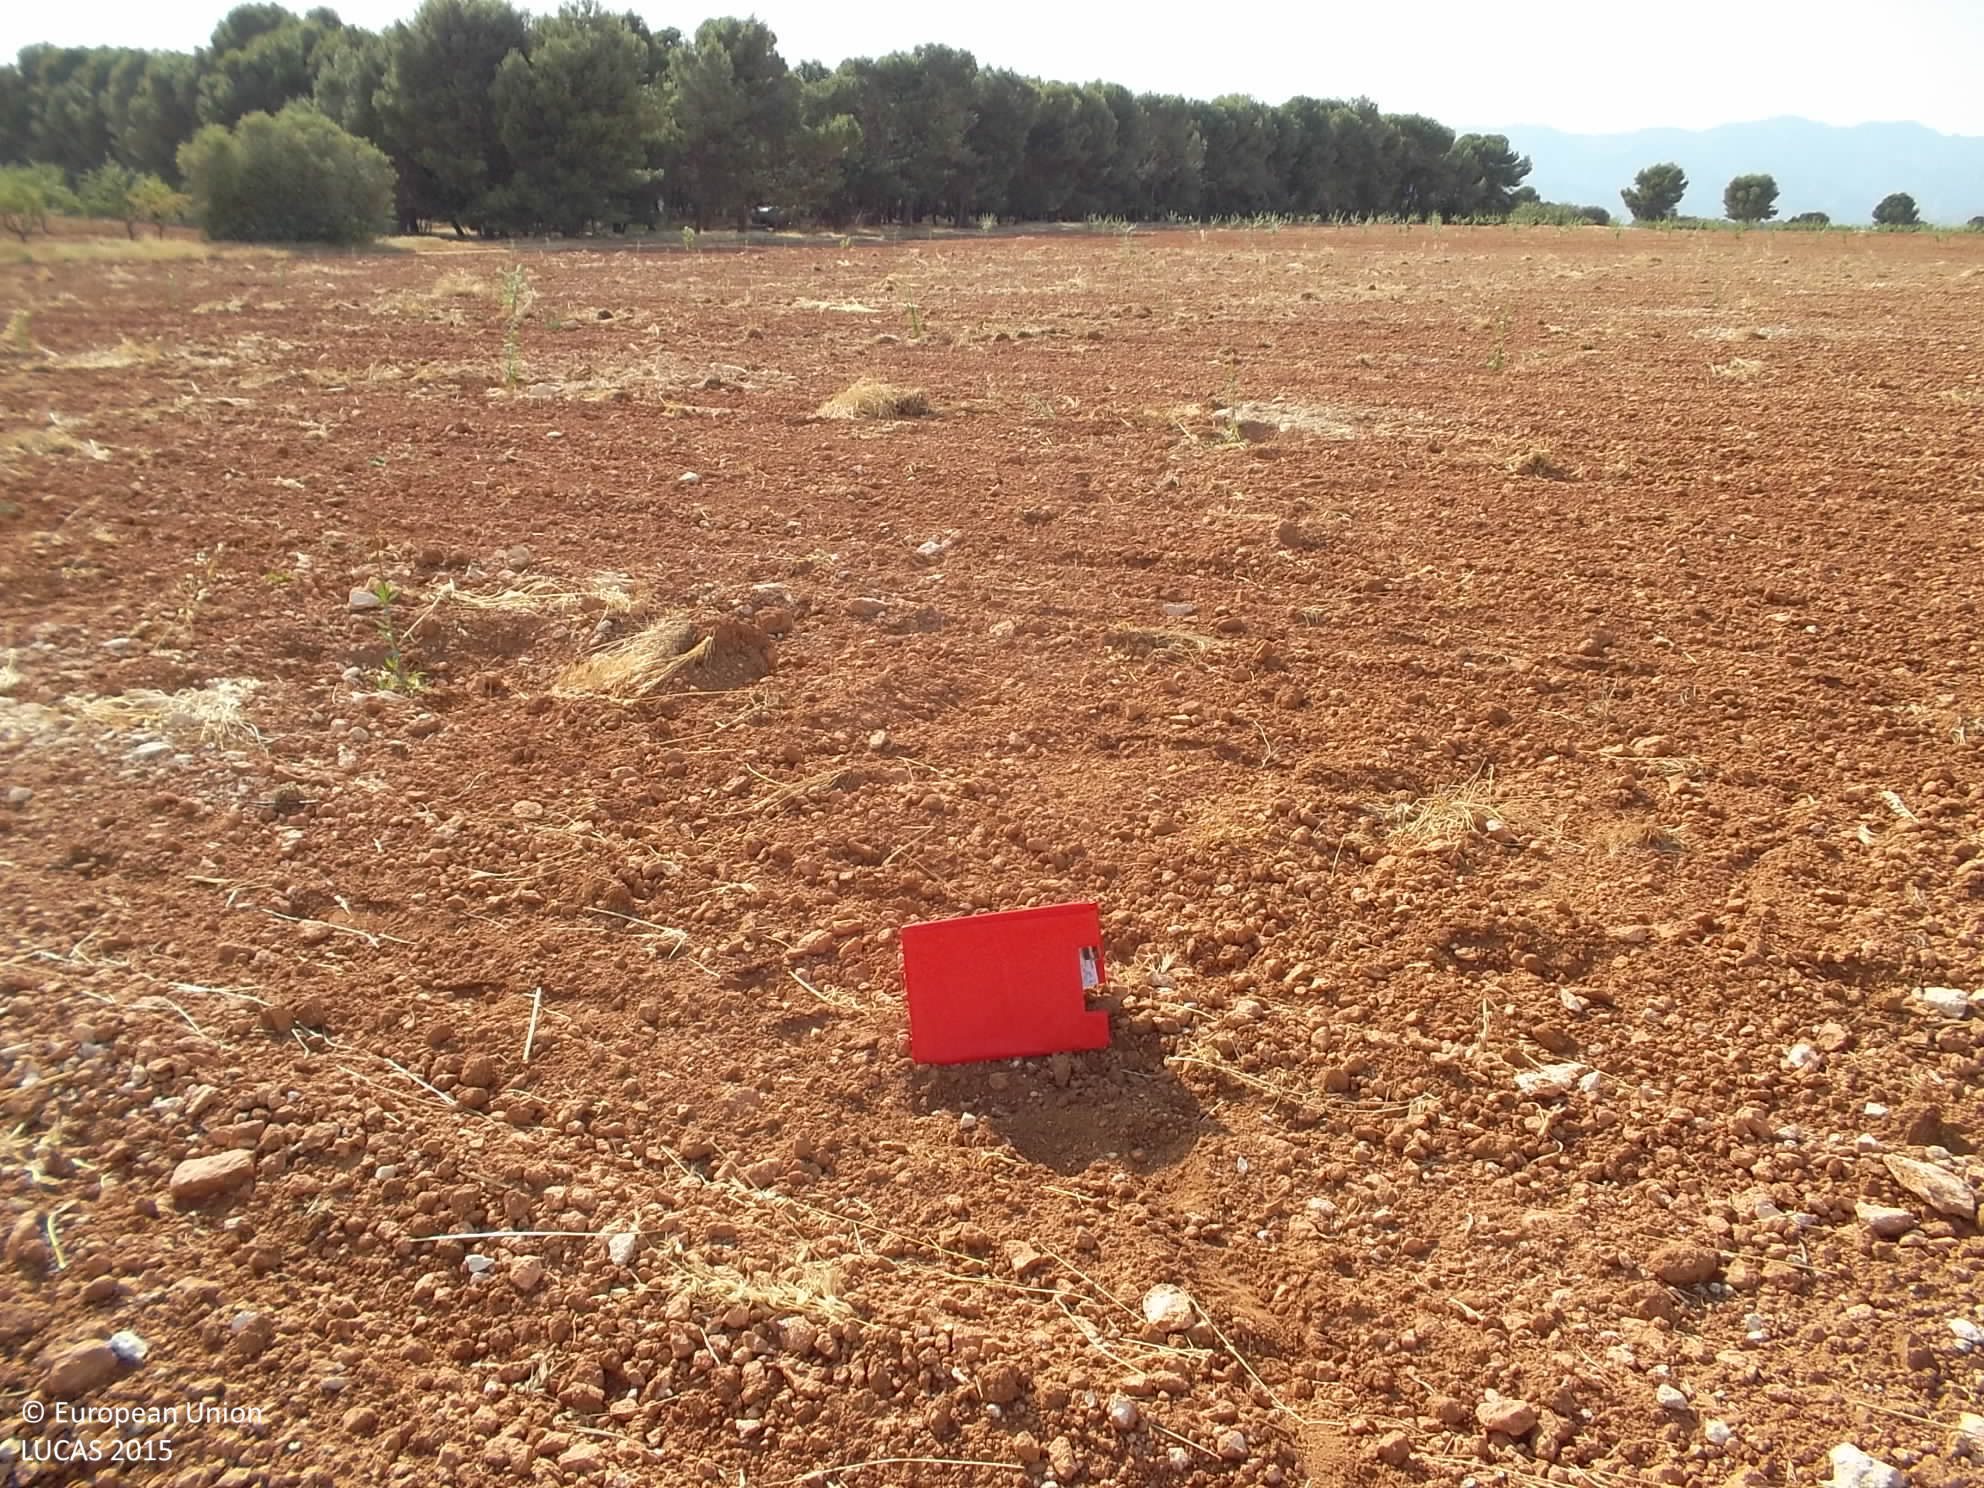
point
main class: Cropland
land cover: Nuts trees
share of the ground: 10 - 25 %
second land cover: Other bare soil
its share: > 75 %
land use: Agriculture (excluding fallow land and kitchen gardens)
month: June
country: ES
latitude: 37.6773
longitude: -2.8596
